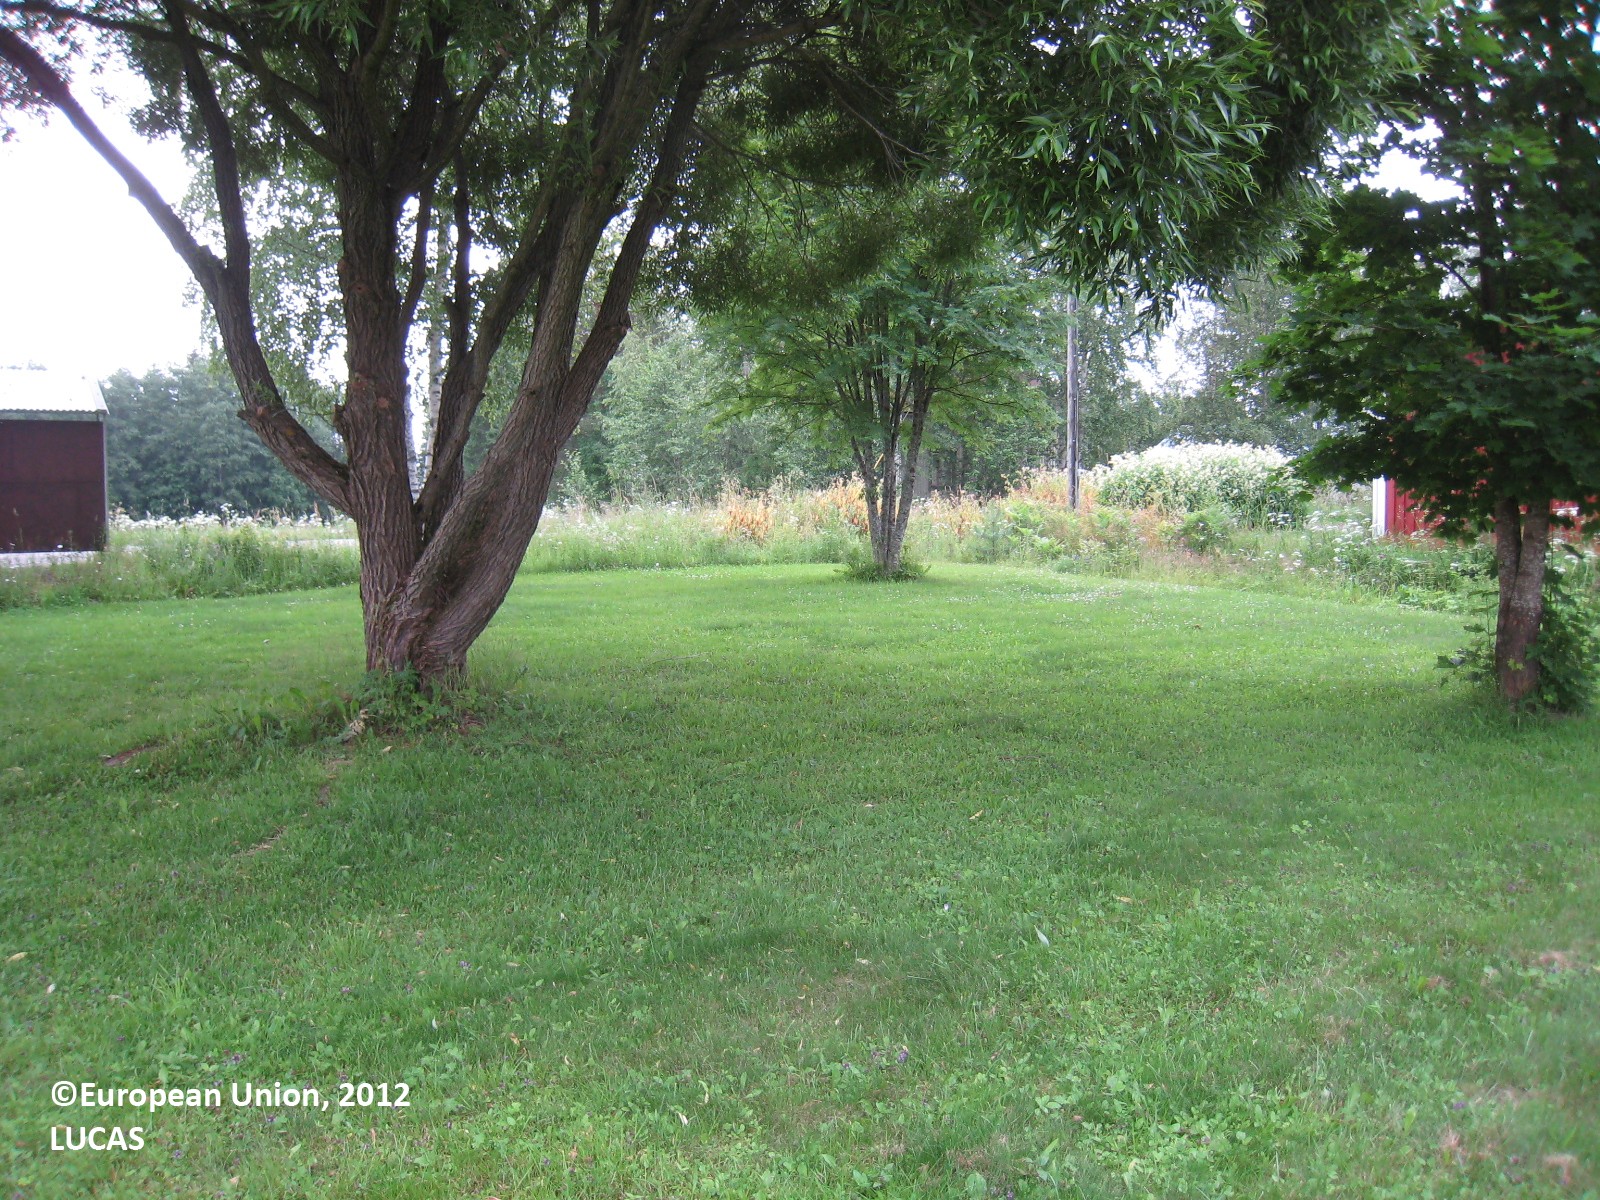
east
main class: Grassland
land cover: Grassland with sparse tree/shrub cover
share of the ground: > 75 %
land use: Residential
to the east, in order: Grassland with sparse tree/shrub cover; Shruby margins; Paved roads, cycling and walking lanes; Shruby margins; Ditches and canals; Grassland without tree/shrub cover; Electric lines; Pine dominated mixed woodland; Electric lines; Spruce dominated mixed woodland; Spruce dominated coniferous woodland; Broadleaved woodland; Spruce dominated mixed woodland; Ditches and canals; Spruce dominated mixed woodland; Other mixed woodland; Inland marshes
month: July
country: FI
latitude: 61.8284
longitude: 27.3922
